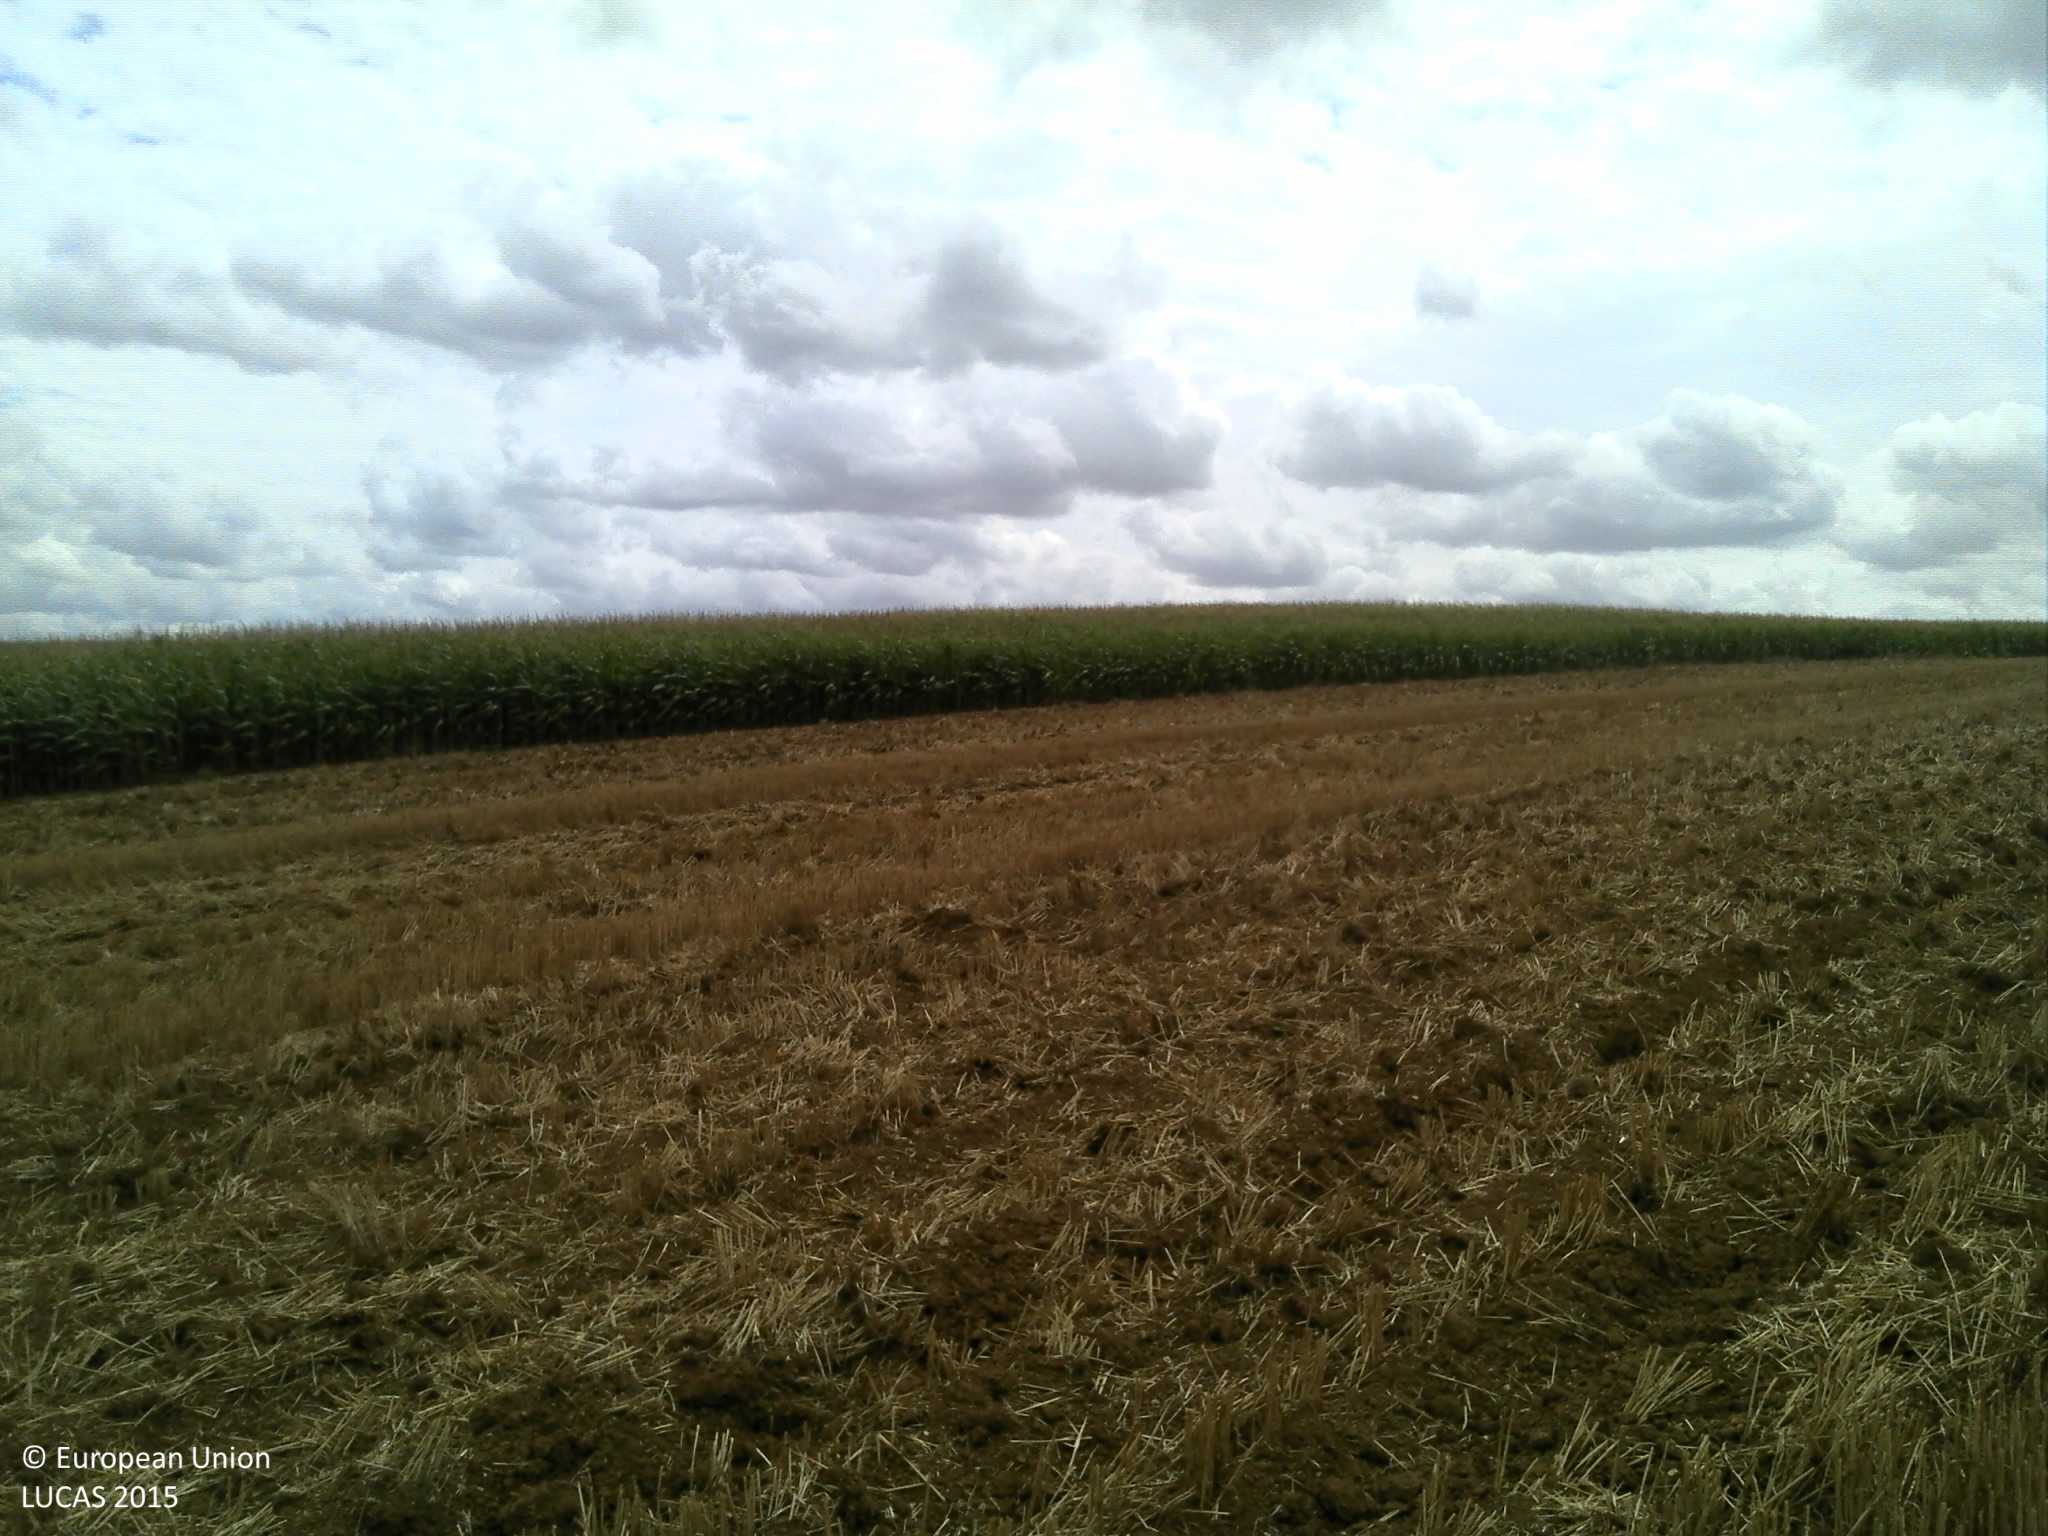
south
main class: Cropland
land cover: Common wheat
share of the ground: 50 - 75 %
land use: Agriculture (excluding fallow land and kitchen gardens)
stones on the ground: < 10 %
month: July
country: FR
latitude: 49.6174
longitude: 4.1125
